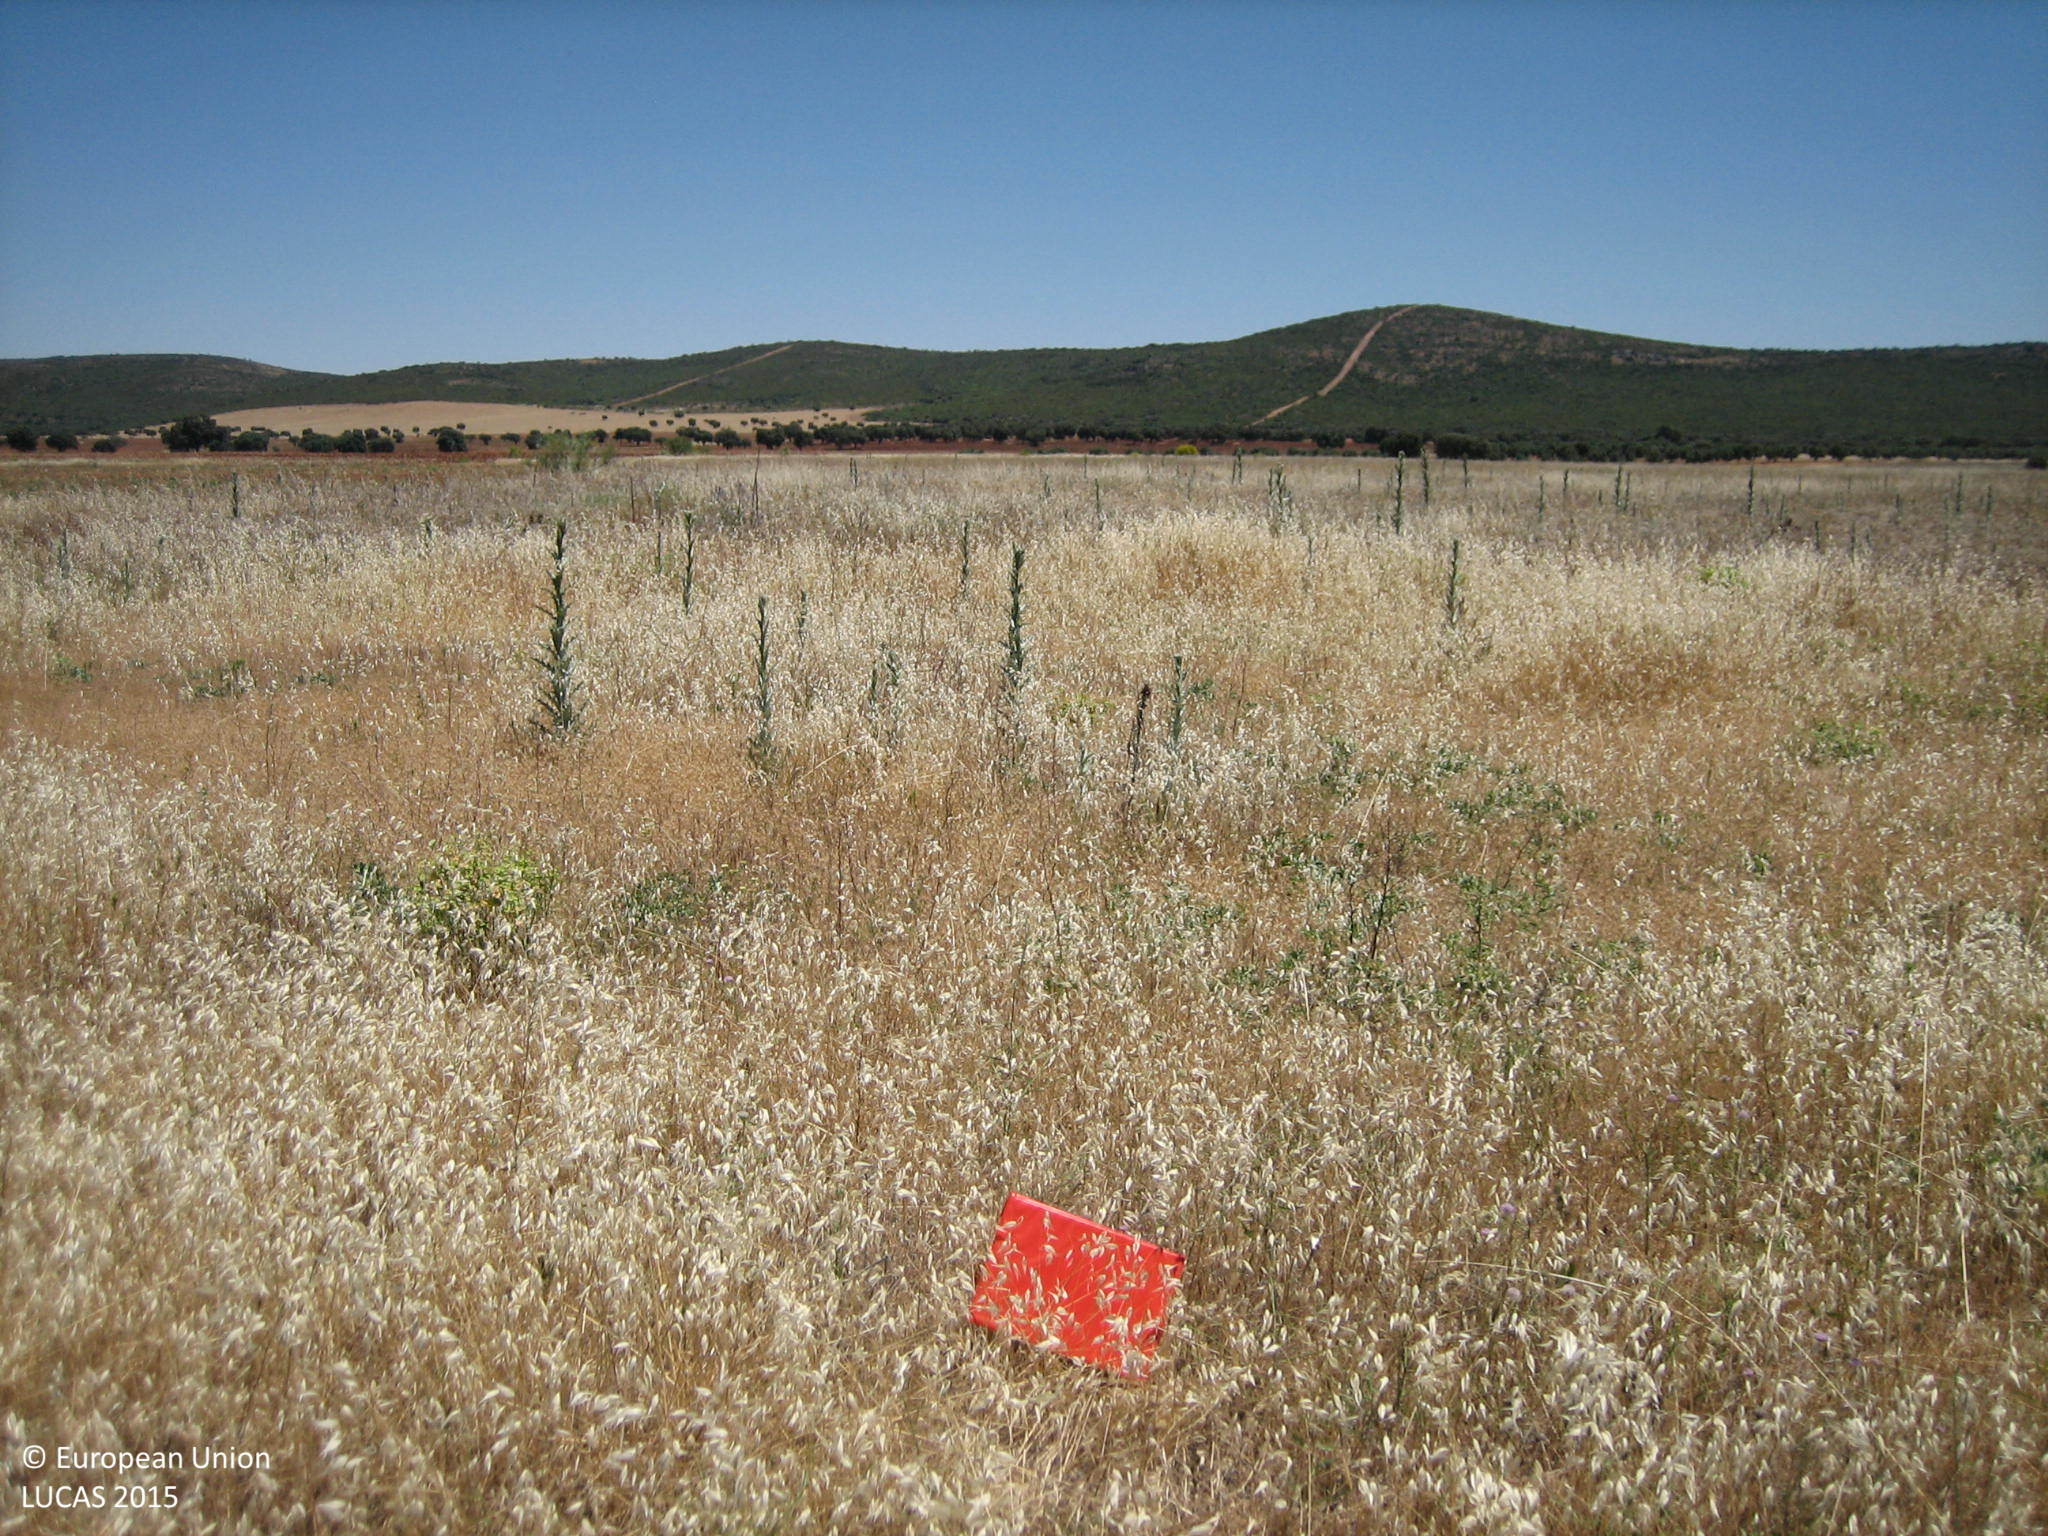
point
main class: Grassland
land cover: Spontaneously vegetated surfaces
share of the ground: > 75 %
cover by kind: herbaceous plants 100 %
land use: Fallow land
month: June
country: ES
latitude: 38.7772
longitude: -4.0271
